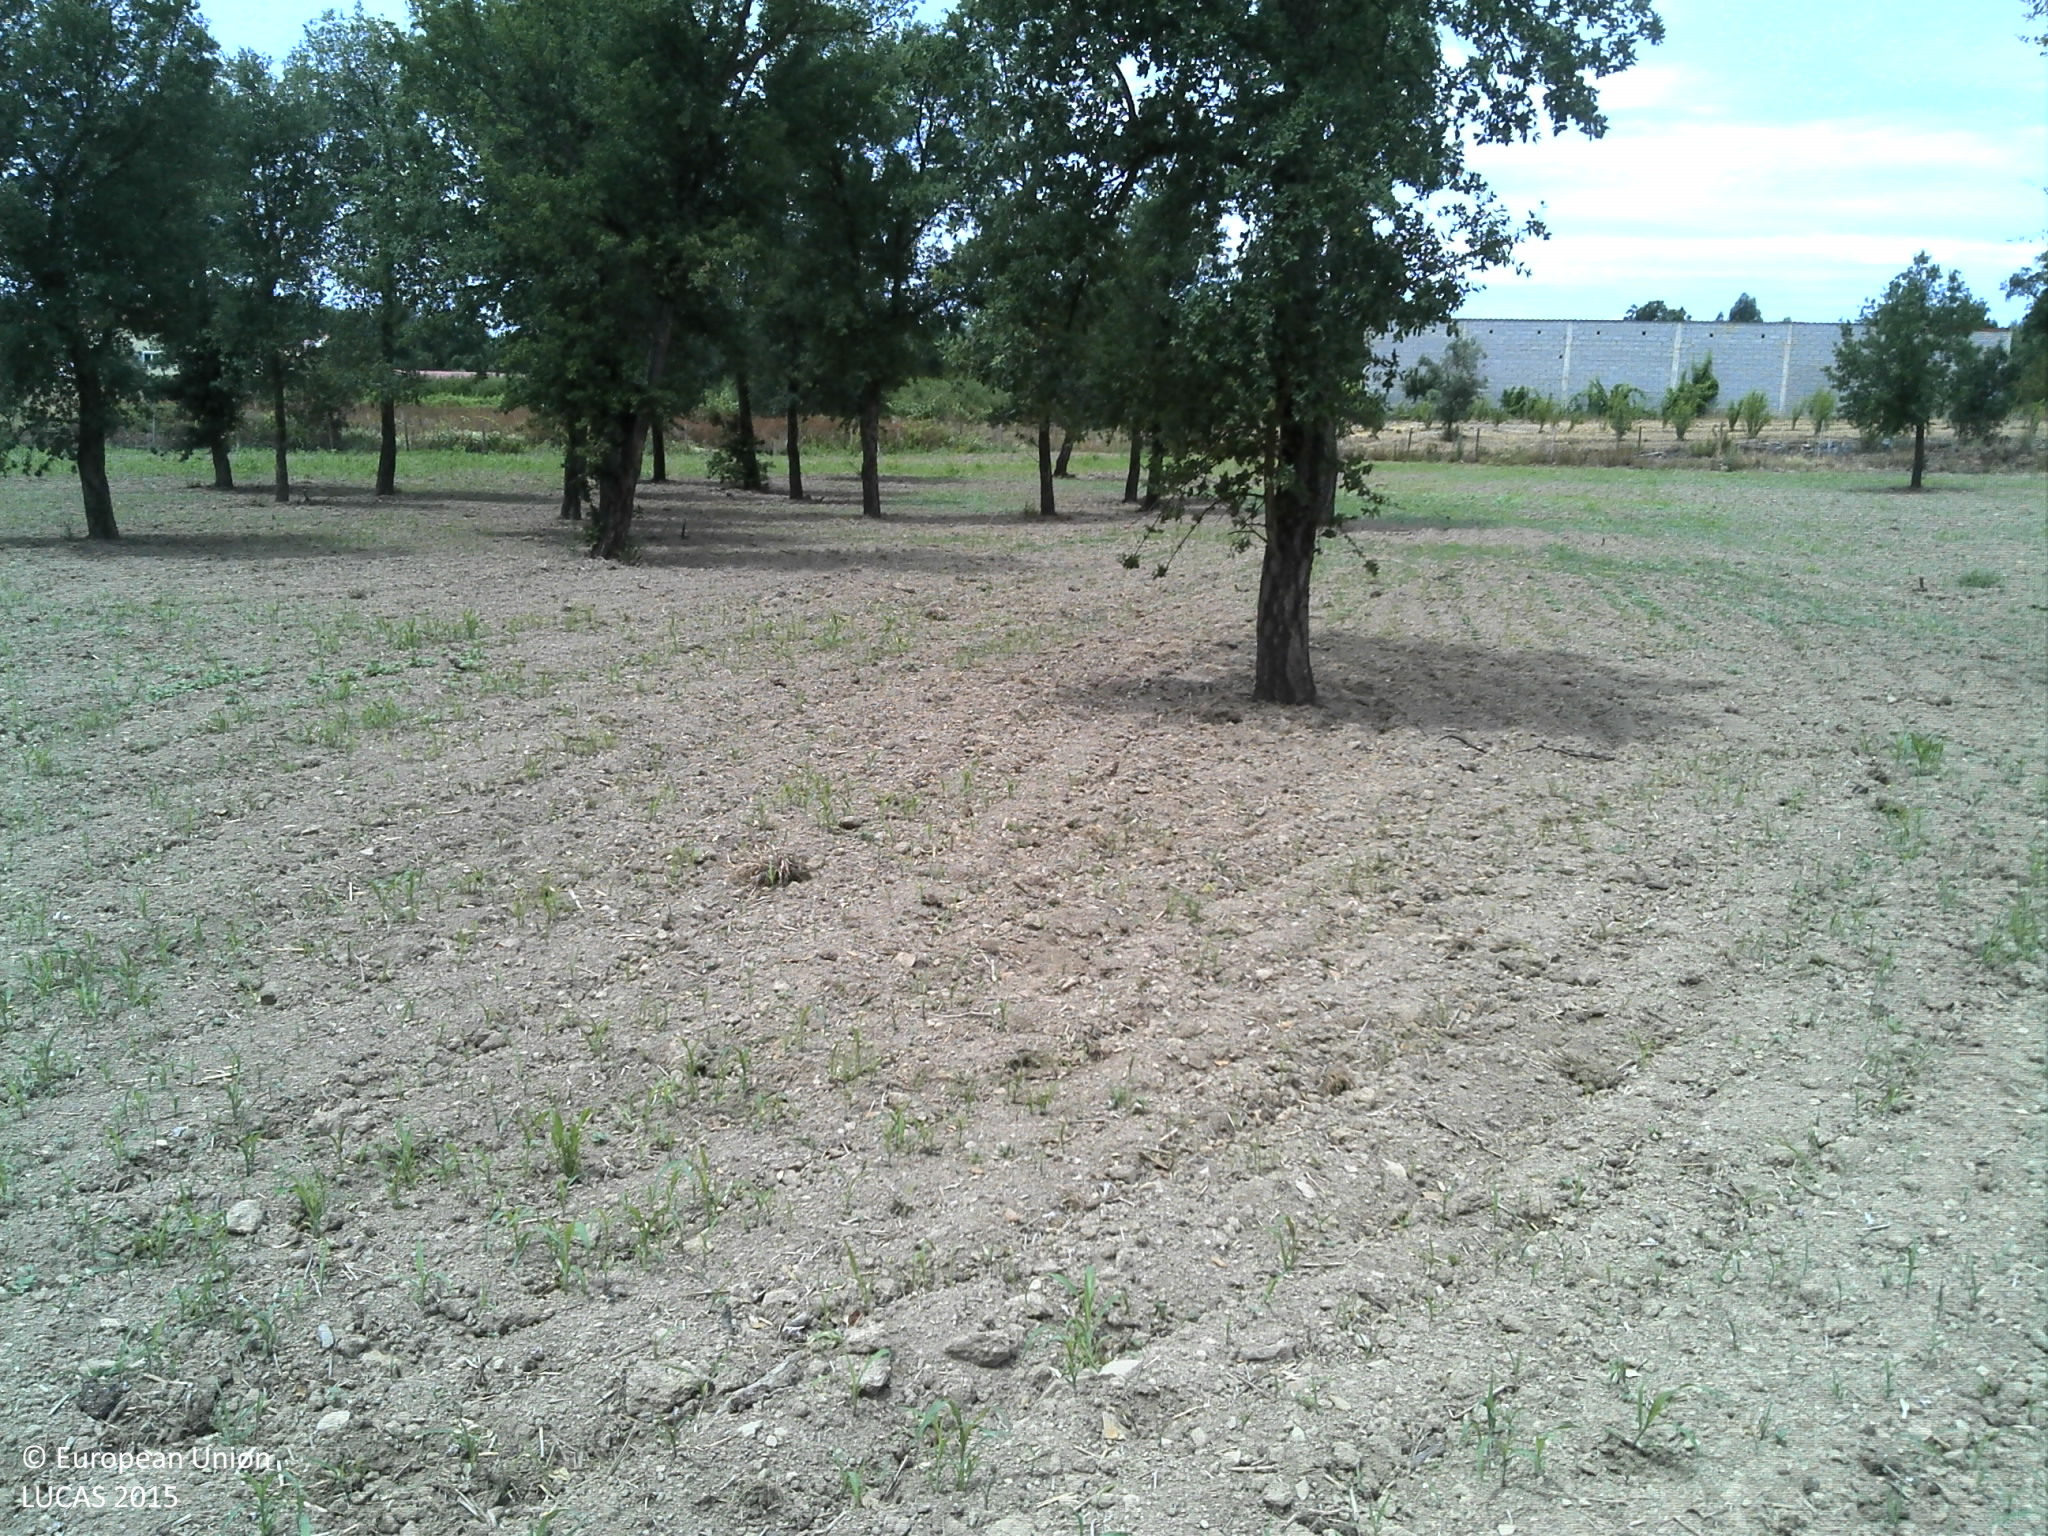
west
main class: Cropland
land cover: Durum wheat
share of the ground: < 10 %
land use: Agriculture (excluding fallow land and kitchen gardens)
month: July
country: PT
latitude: 39.6726
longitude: -8.1236
